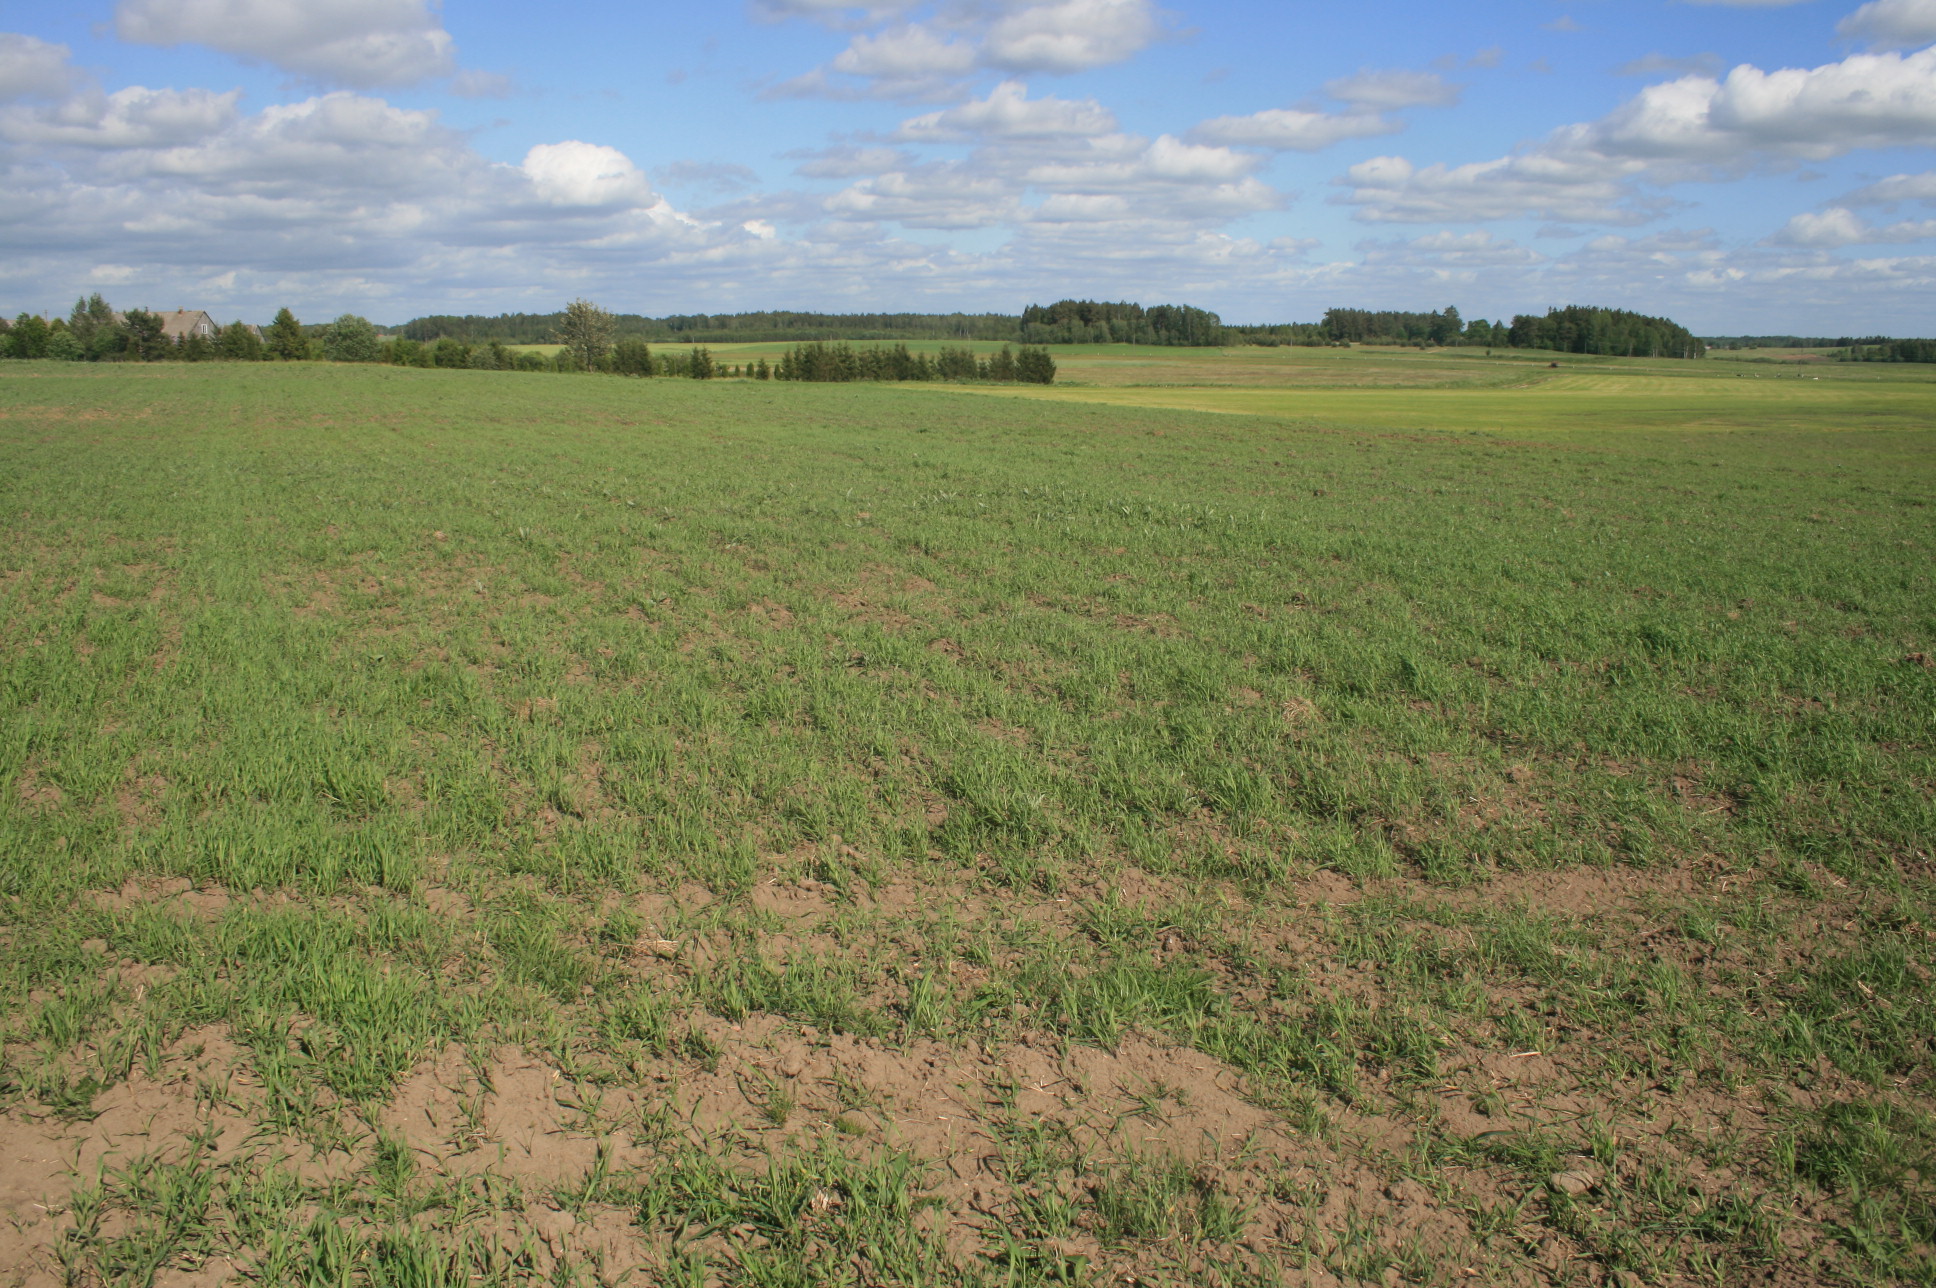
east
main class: Cropland
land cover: Barley
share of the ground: > 75 %
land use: Agriculture (excluding fallow land and kitchen gardens)
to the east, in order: Barley; Spontaneously vegetated surfaces; Ditches and canals
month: June
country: LT
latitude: 56.0449
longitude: 22.3373
